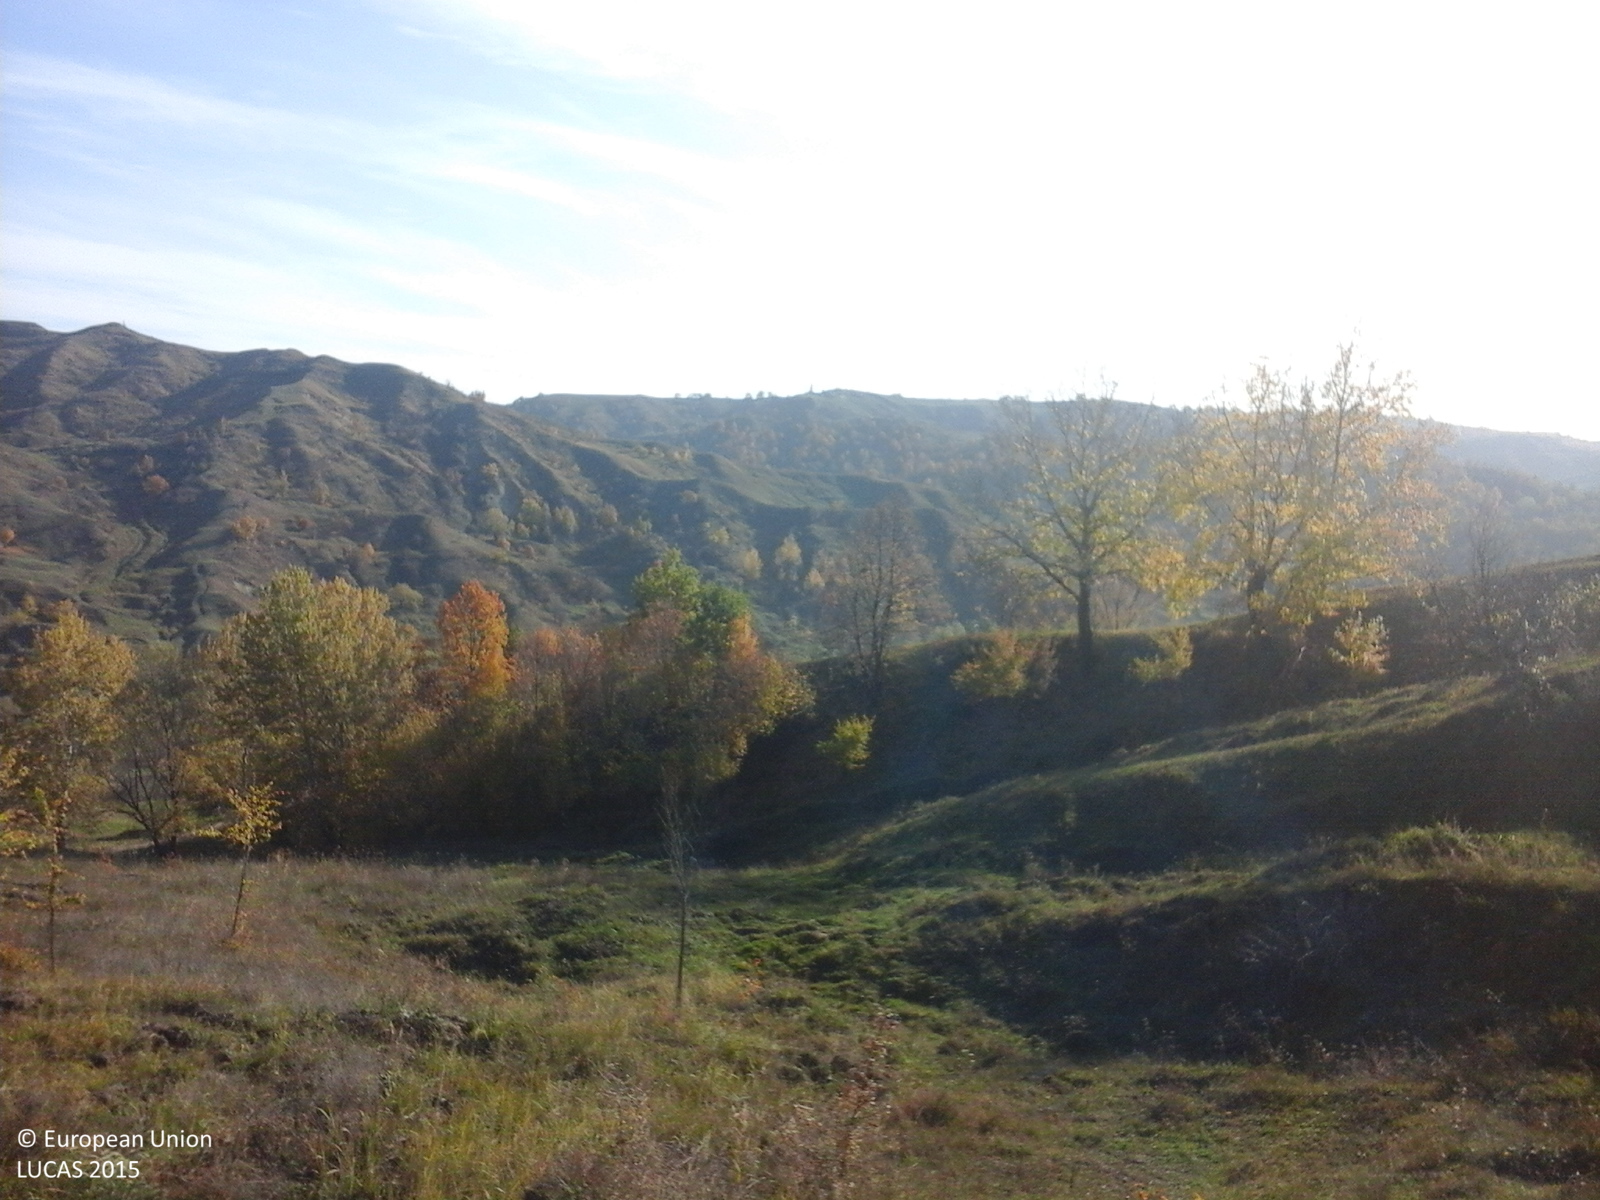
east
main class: Grassland
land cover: Grassland with sparse tree/shrub cover
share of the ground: > 75 %
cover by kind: herbaceous plants 85 %, shrubs 10 %, broadleaved forest trees 5 %
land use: Fallow land
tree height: < 5 m
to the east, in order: Grassland with sparse tree/shrub cover; Broadleaved woodland; Grassland with sparse tree/shrub cover; Tracks; Grass margins; Single bushes/trees; Grassland without tree/shrub cover; Tracks; Grassland without tree/shrub cover; Single bushes/trees; Grassland without tree/shrub cover
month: October
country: RO
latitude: 45.6460
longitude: 26.9606
